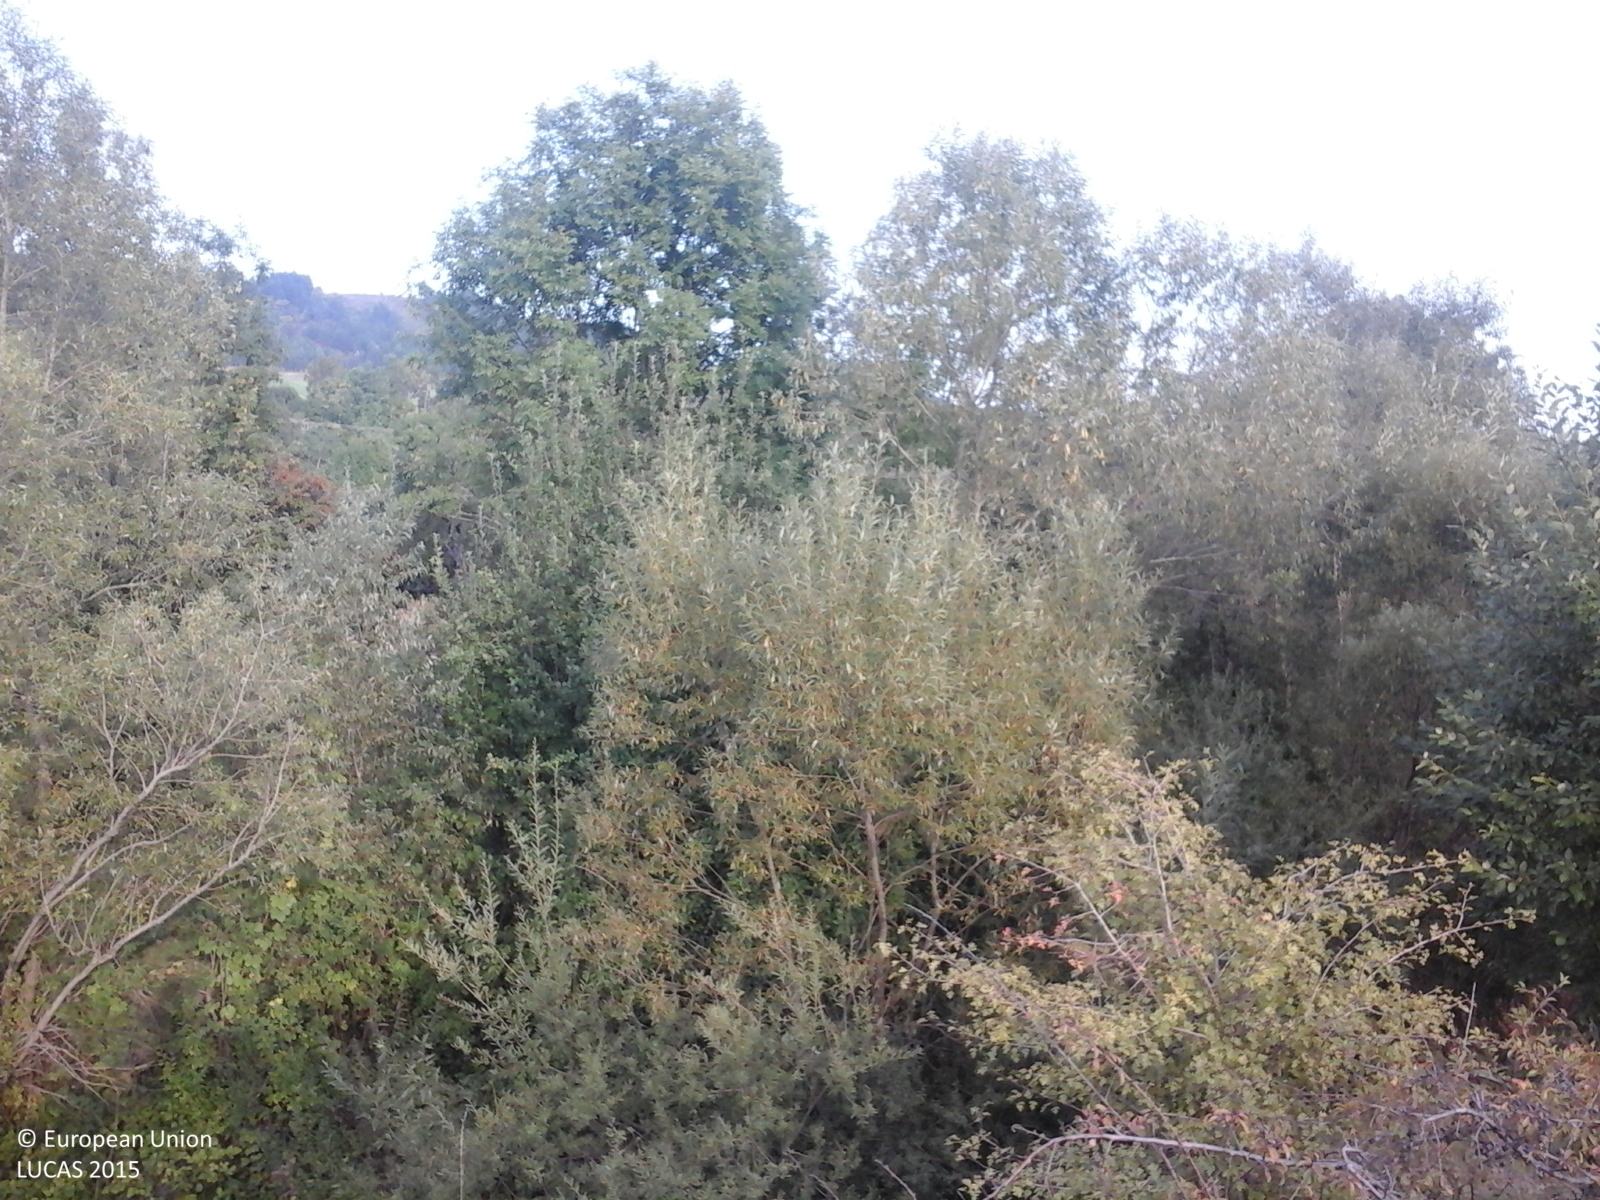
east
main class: Grassland
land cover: Grassland with sparse tree/shrub cover
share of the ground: > 75 %
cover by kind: herbaceous plants 85 %, shrubs 10 %, broadleaved forest trees 5 %
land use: Fallow land
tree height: < 5 m
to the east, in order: Grassland with sparse tree/shrub cover; Rivers and streams; Broadleaved woodland; Grassland without tree/shrub cover; Fences; Apple fruit; Lucerne; Fences; Abandoned hedges; Grass margins; Ditches and canals; Grass margins; Paved roads, cycling and walking lanes; Grass margins; Rivers and streams; Grass margins; Abandoned hedges; Fences; Grassland without tree/shrub cover; Electric lines; Lucerne; Grass margins; Broadleaved woodland; Fences; Tracks; Grassland without tree/shrub cover
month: September
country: RO
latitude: 46.8269
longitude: 23.0264
